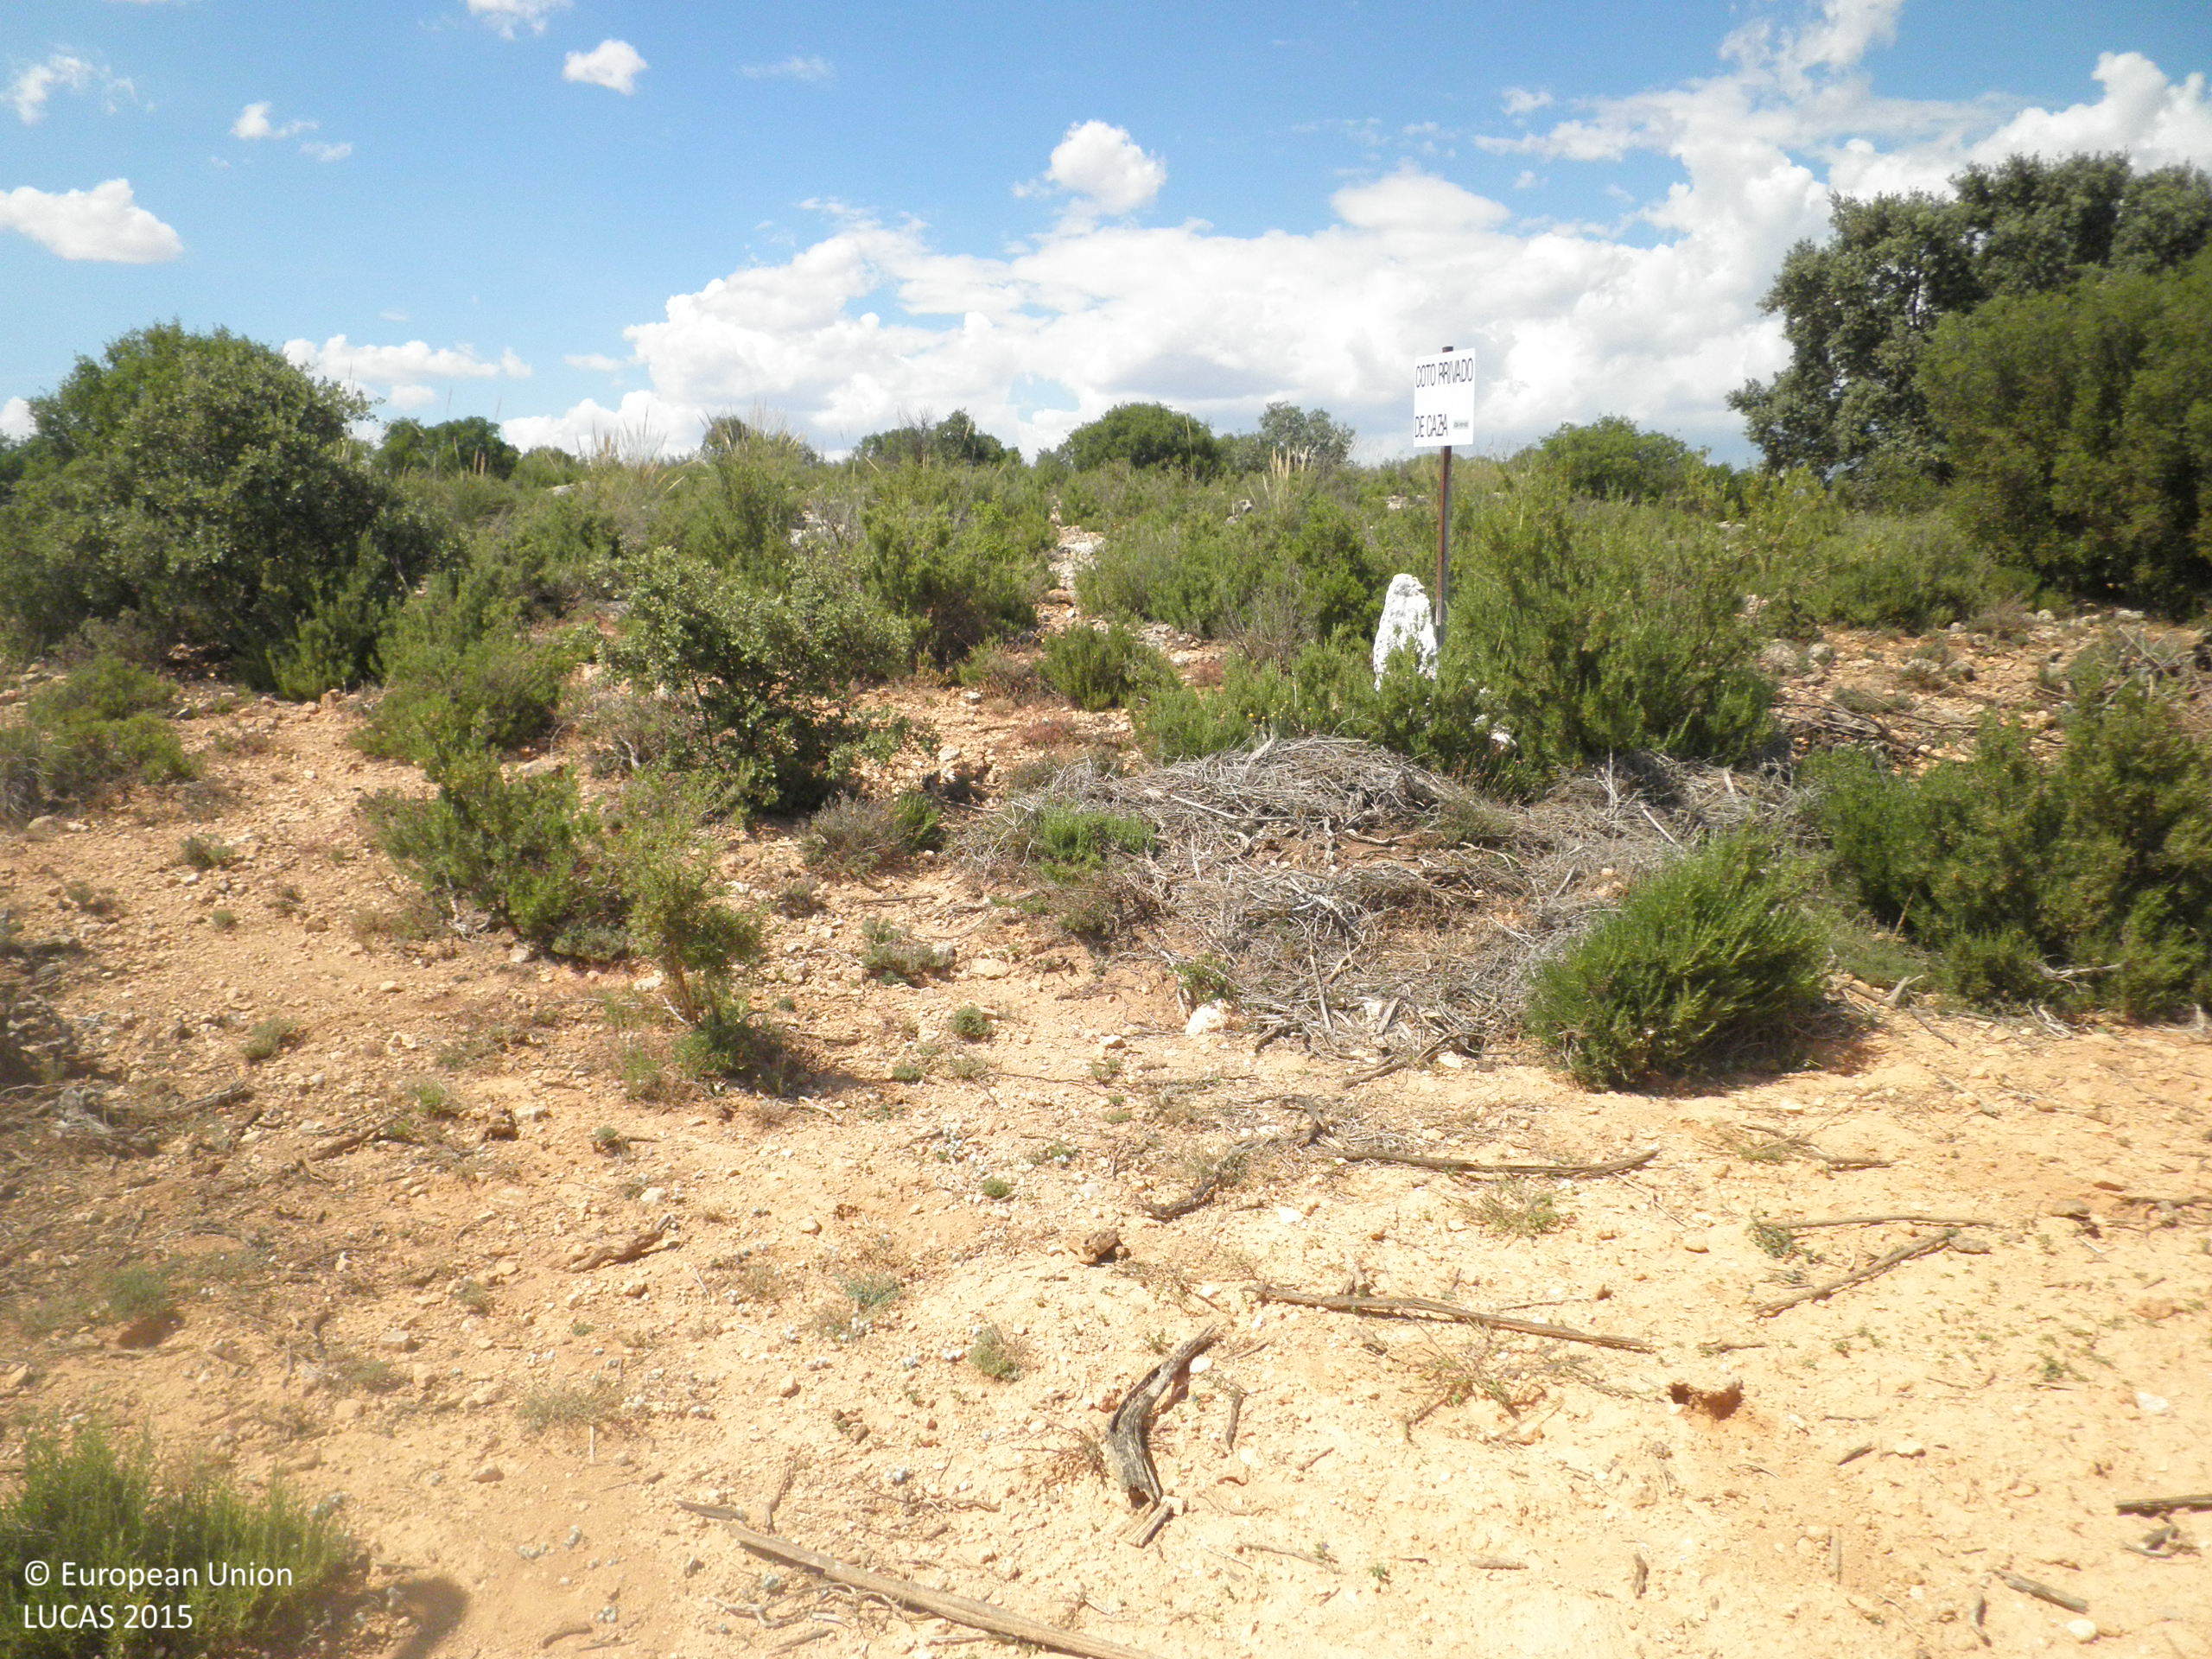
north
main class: Cropland
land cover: Nuts trees
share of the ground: < 10 %
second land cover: Other bare soil
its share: > 75 %
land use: Agriculture (excluding fallow land and kitchen gardens)
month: June
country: ES
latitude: 39.4816
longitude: -1.7829
